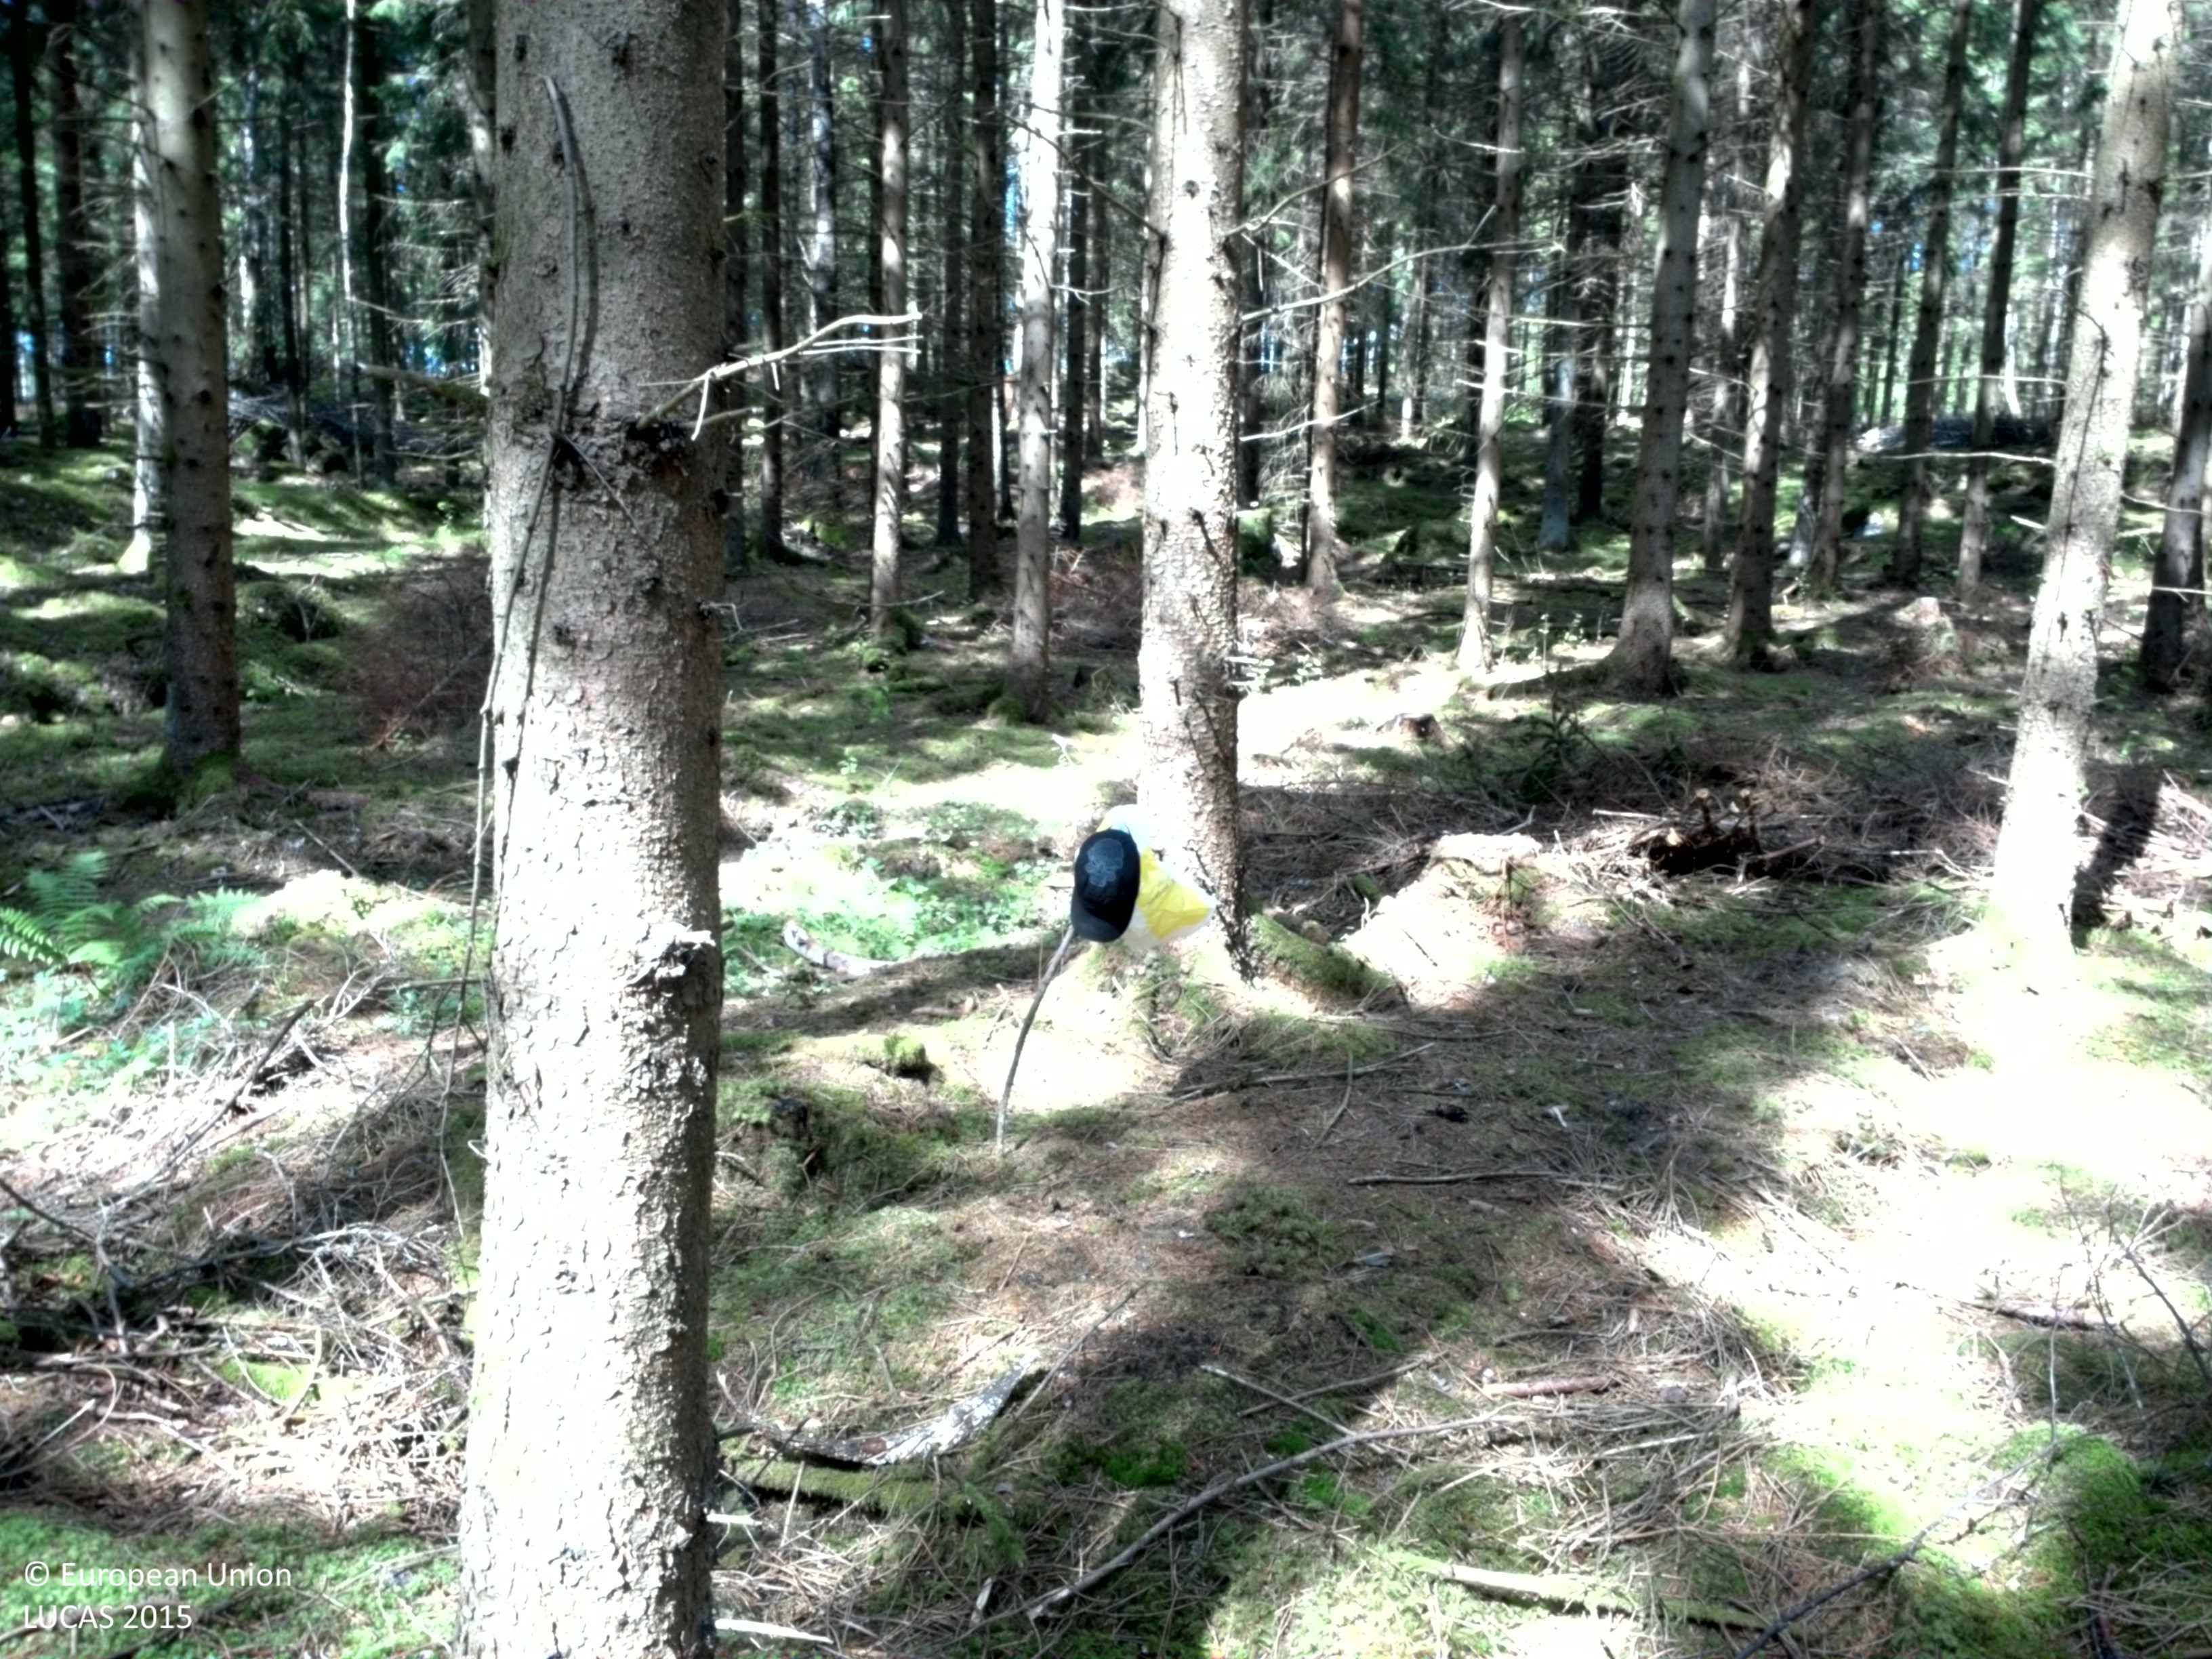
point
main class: Woodland
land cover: Spruce dominated coniferous woodland
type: boreal forest
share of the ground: 50 - 75 %
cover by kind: coniferous forest trees 75 %, lichens and mosses 10 %, unconsolidated bare surface 10 %, herbaceous plants 5 %
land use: Forestry
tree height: > 5 m
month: July
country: SE
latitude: 58.7180
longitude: 14.0161
